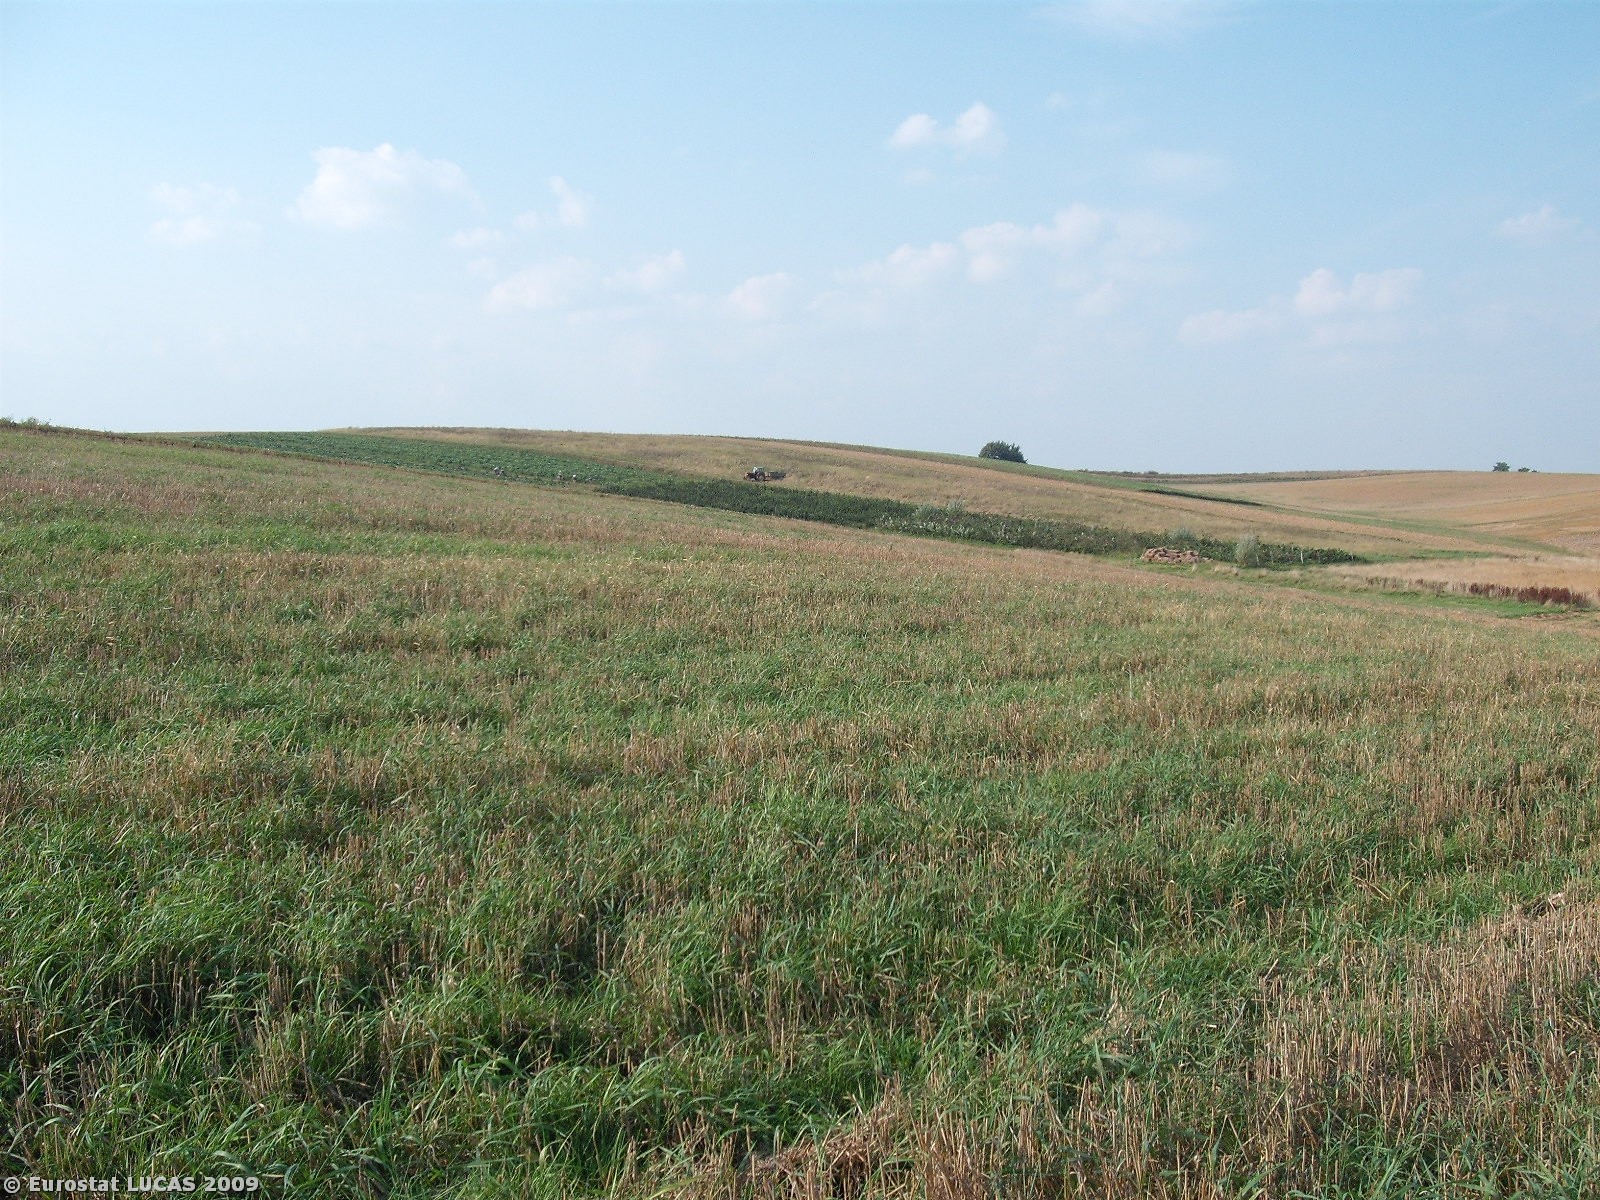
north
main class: Cropland
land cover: Common wheat
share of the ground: < 10 %
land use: Agriculture (excluding fallow land and kitchen gardens)
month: August
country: PL
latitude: 49.9561
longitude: 22.4273
